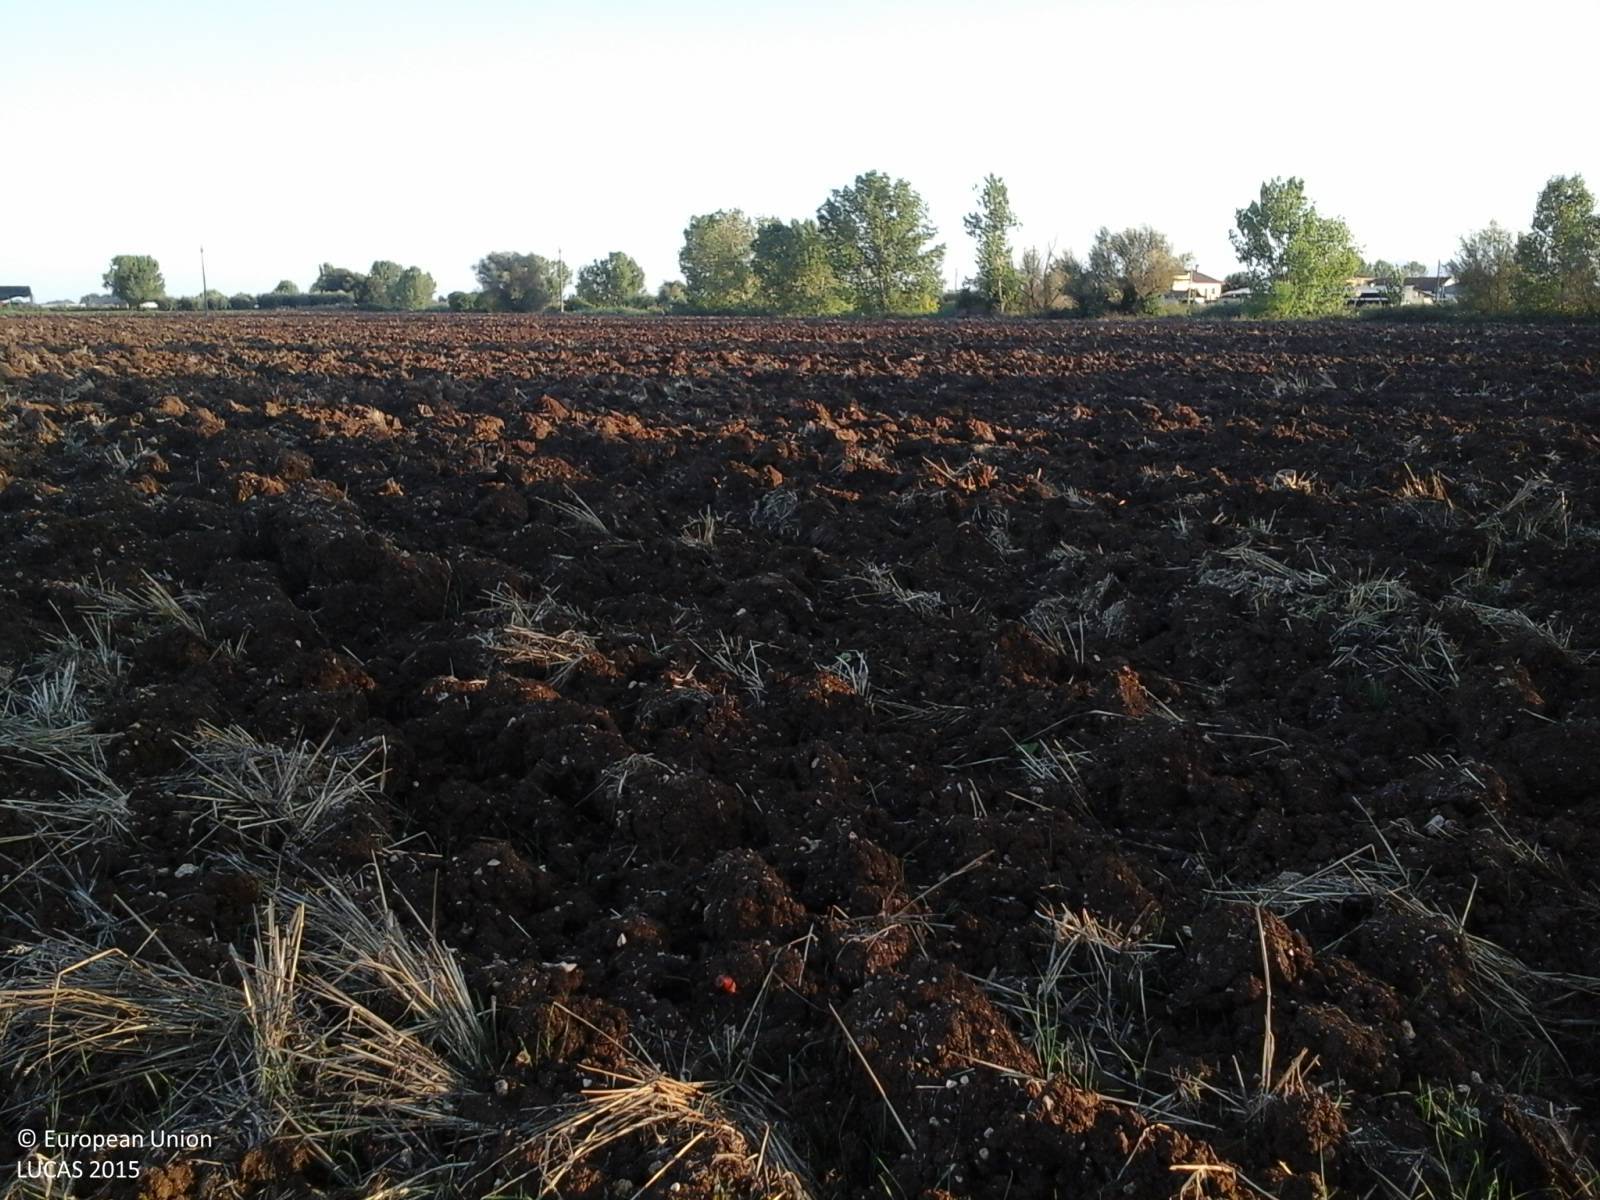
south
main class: Cropland
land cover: Common wheat
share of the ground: < 10 %
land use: Agriculture (excluding fallow land and kitchen gardens)
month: August
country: IT
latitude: 41.3752
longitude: 13.1558
